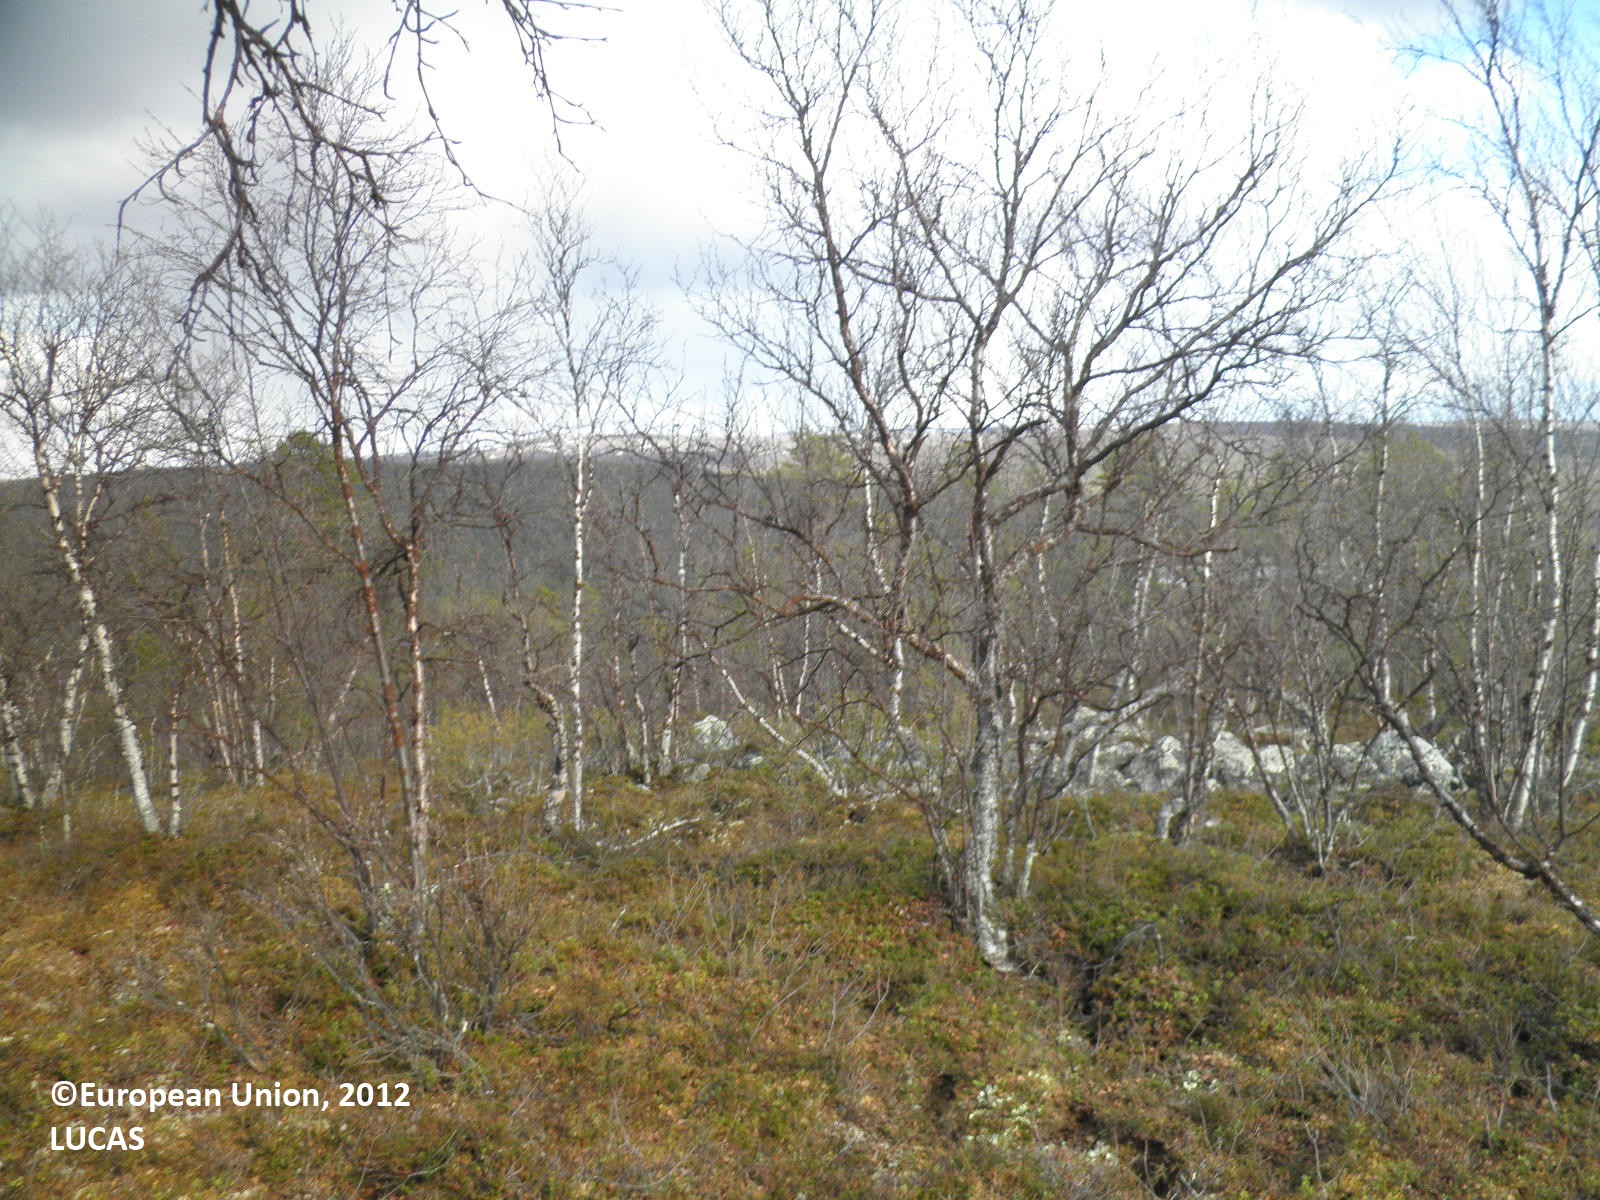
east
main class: Woodland
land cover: Broadleaved woodland
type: hemiboreal forest and nemoral coniferous forest and mixed broadleaved-coniferous forest
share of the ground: 50 - 75 %
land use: Forestry
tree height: > 5 m
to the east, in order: Broadleaved woodland; Pine dominated coniferous woodland; Broadleaved woodland
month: May
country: FI
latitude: 69.7944
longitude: 26.9826
